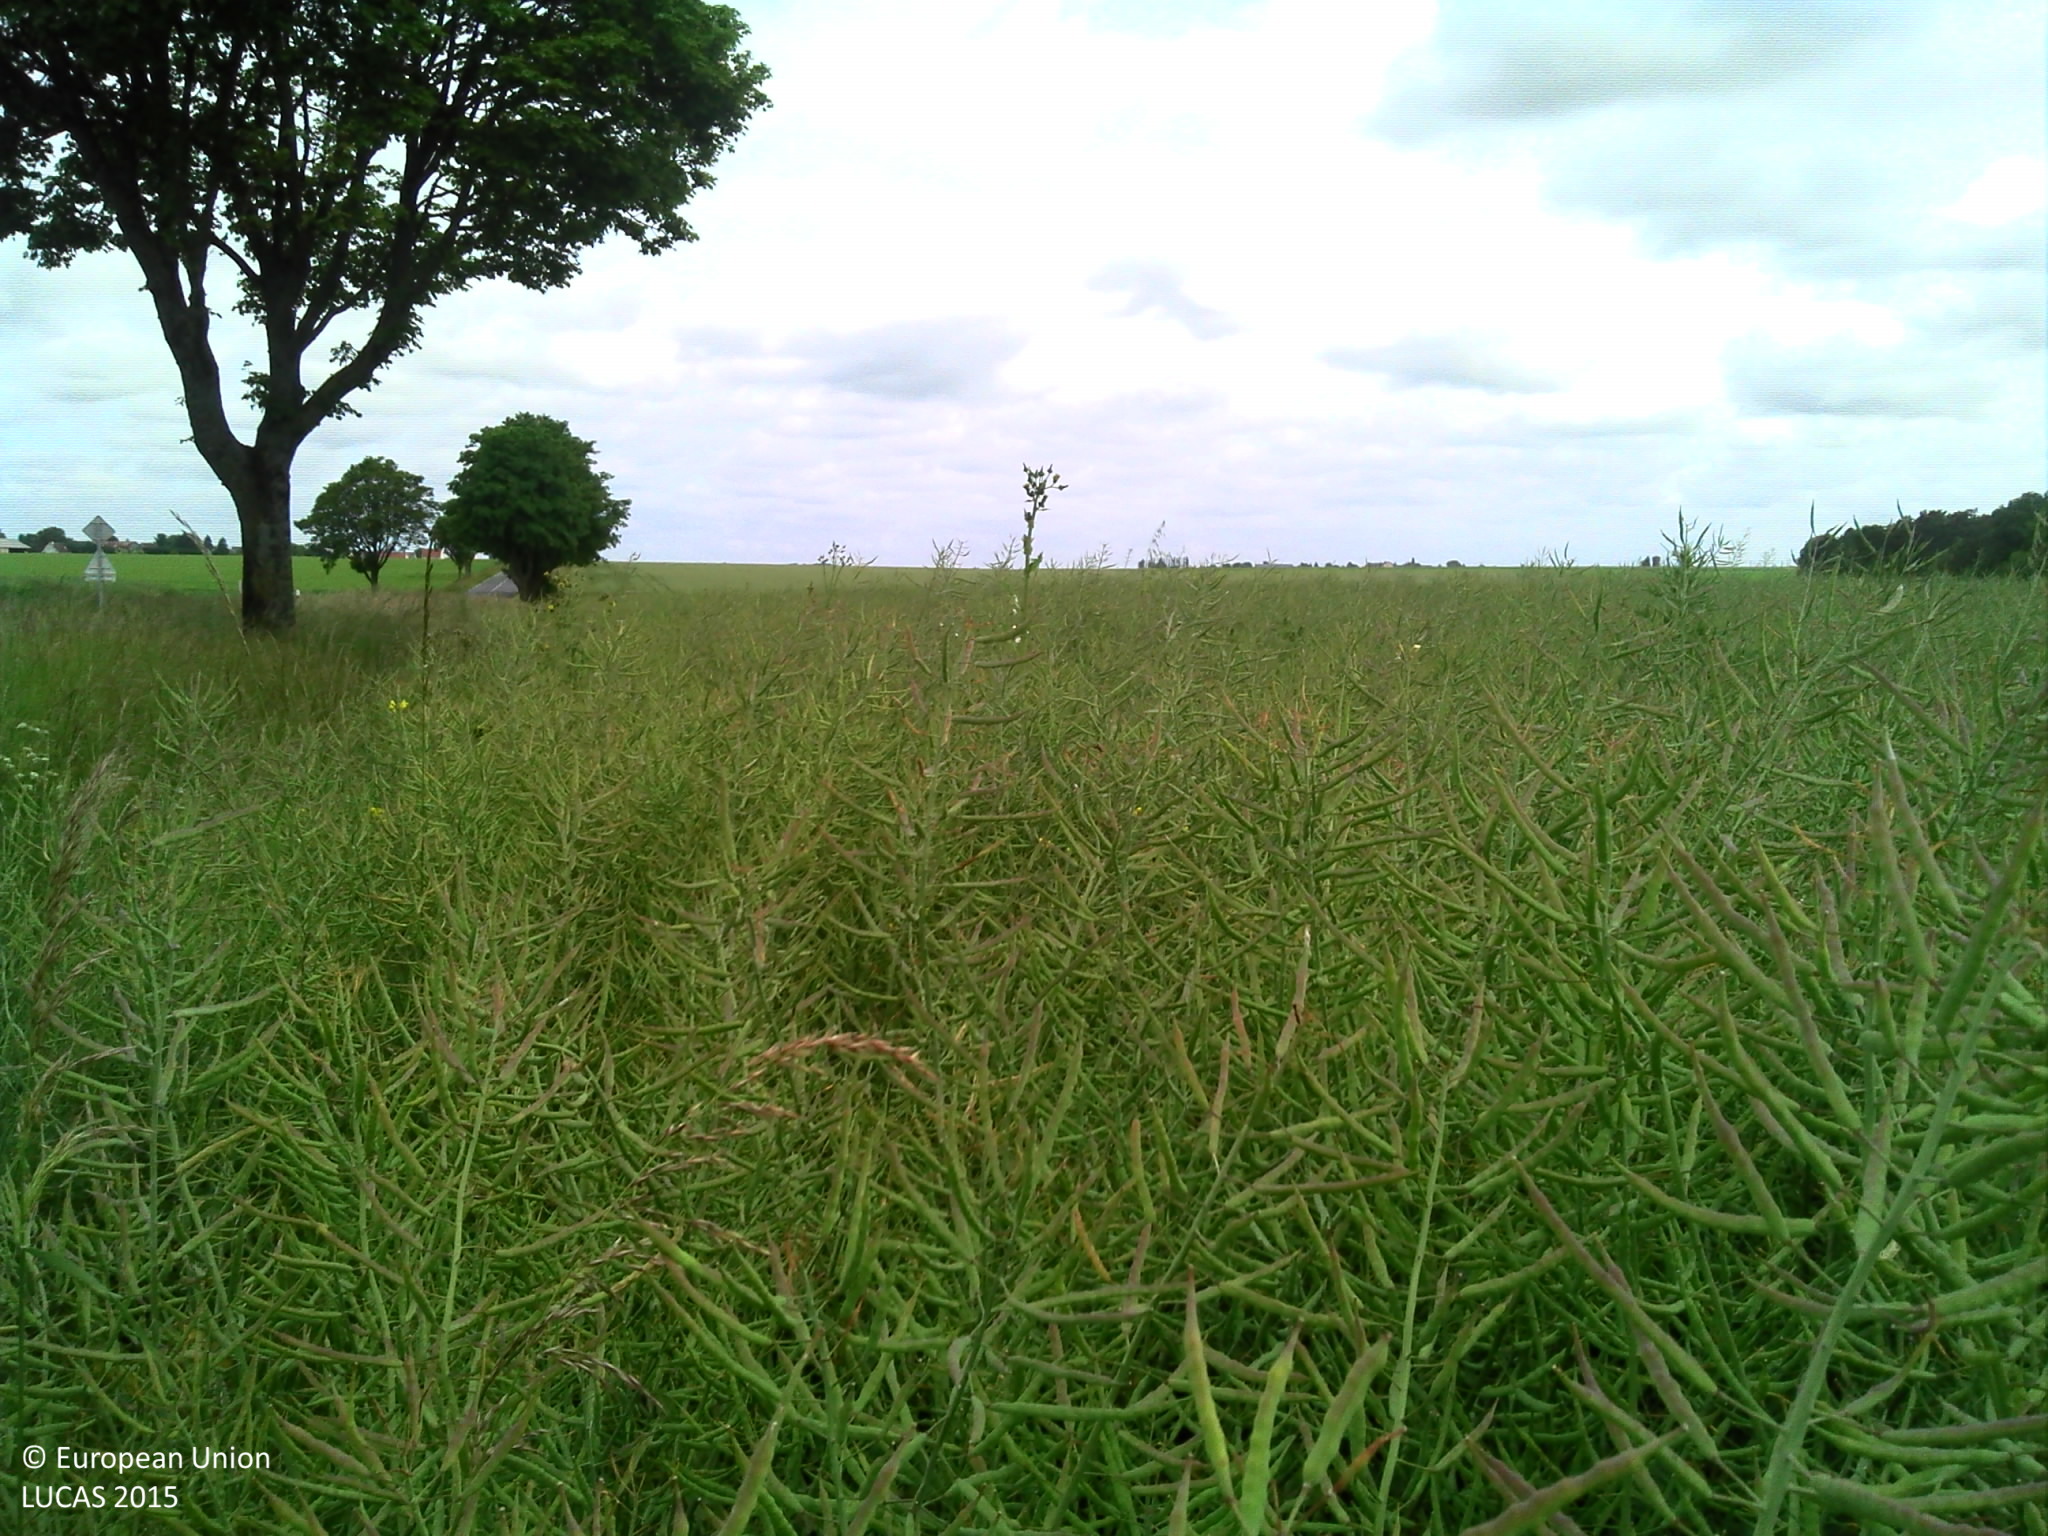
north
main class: Cropland
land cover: Rape and turnip rape
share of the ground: > 75 %
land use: Agriculture (excluding fallow land and kitchen gardens)
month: June
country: FR
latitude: 48.3652
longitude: 1.9824
